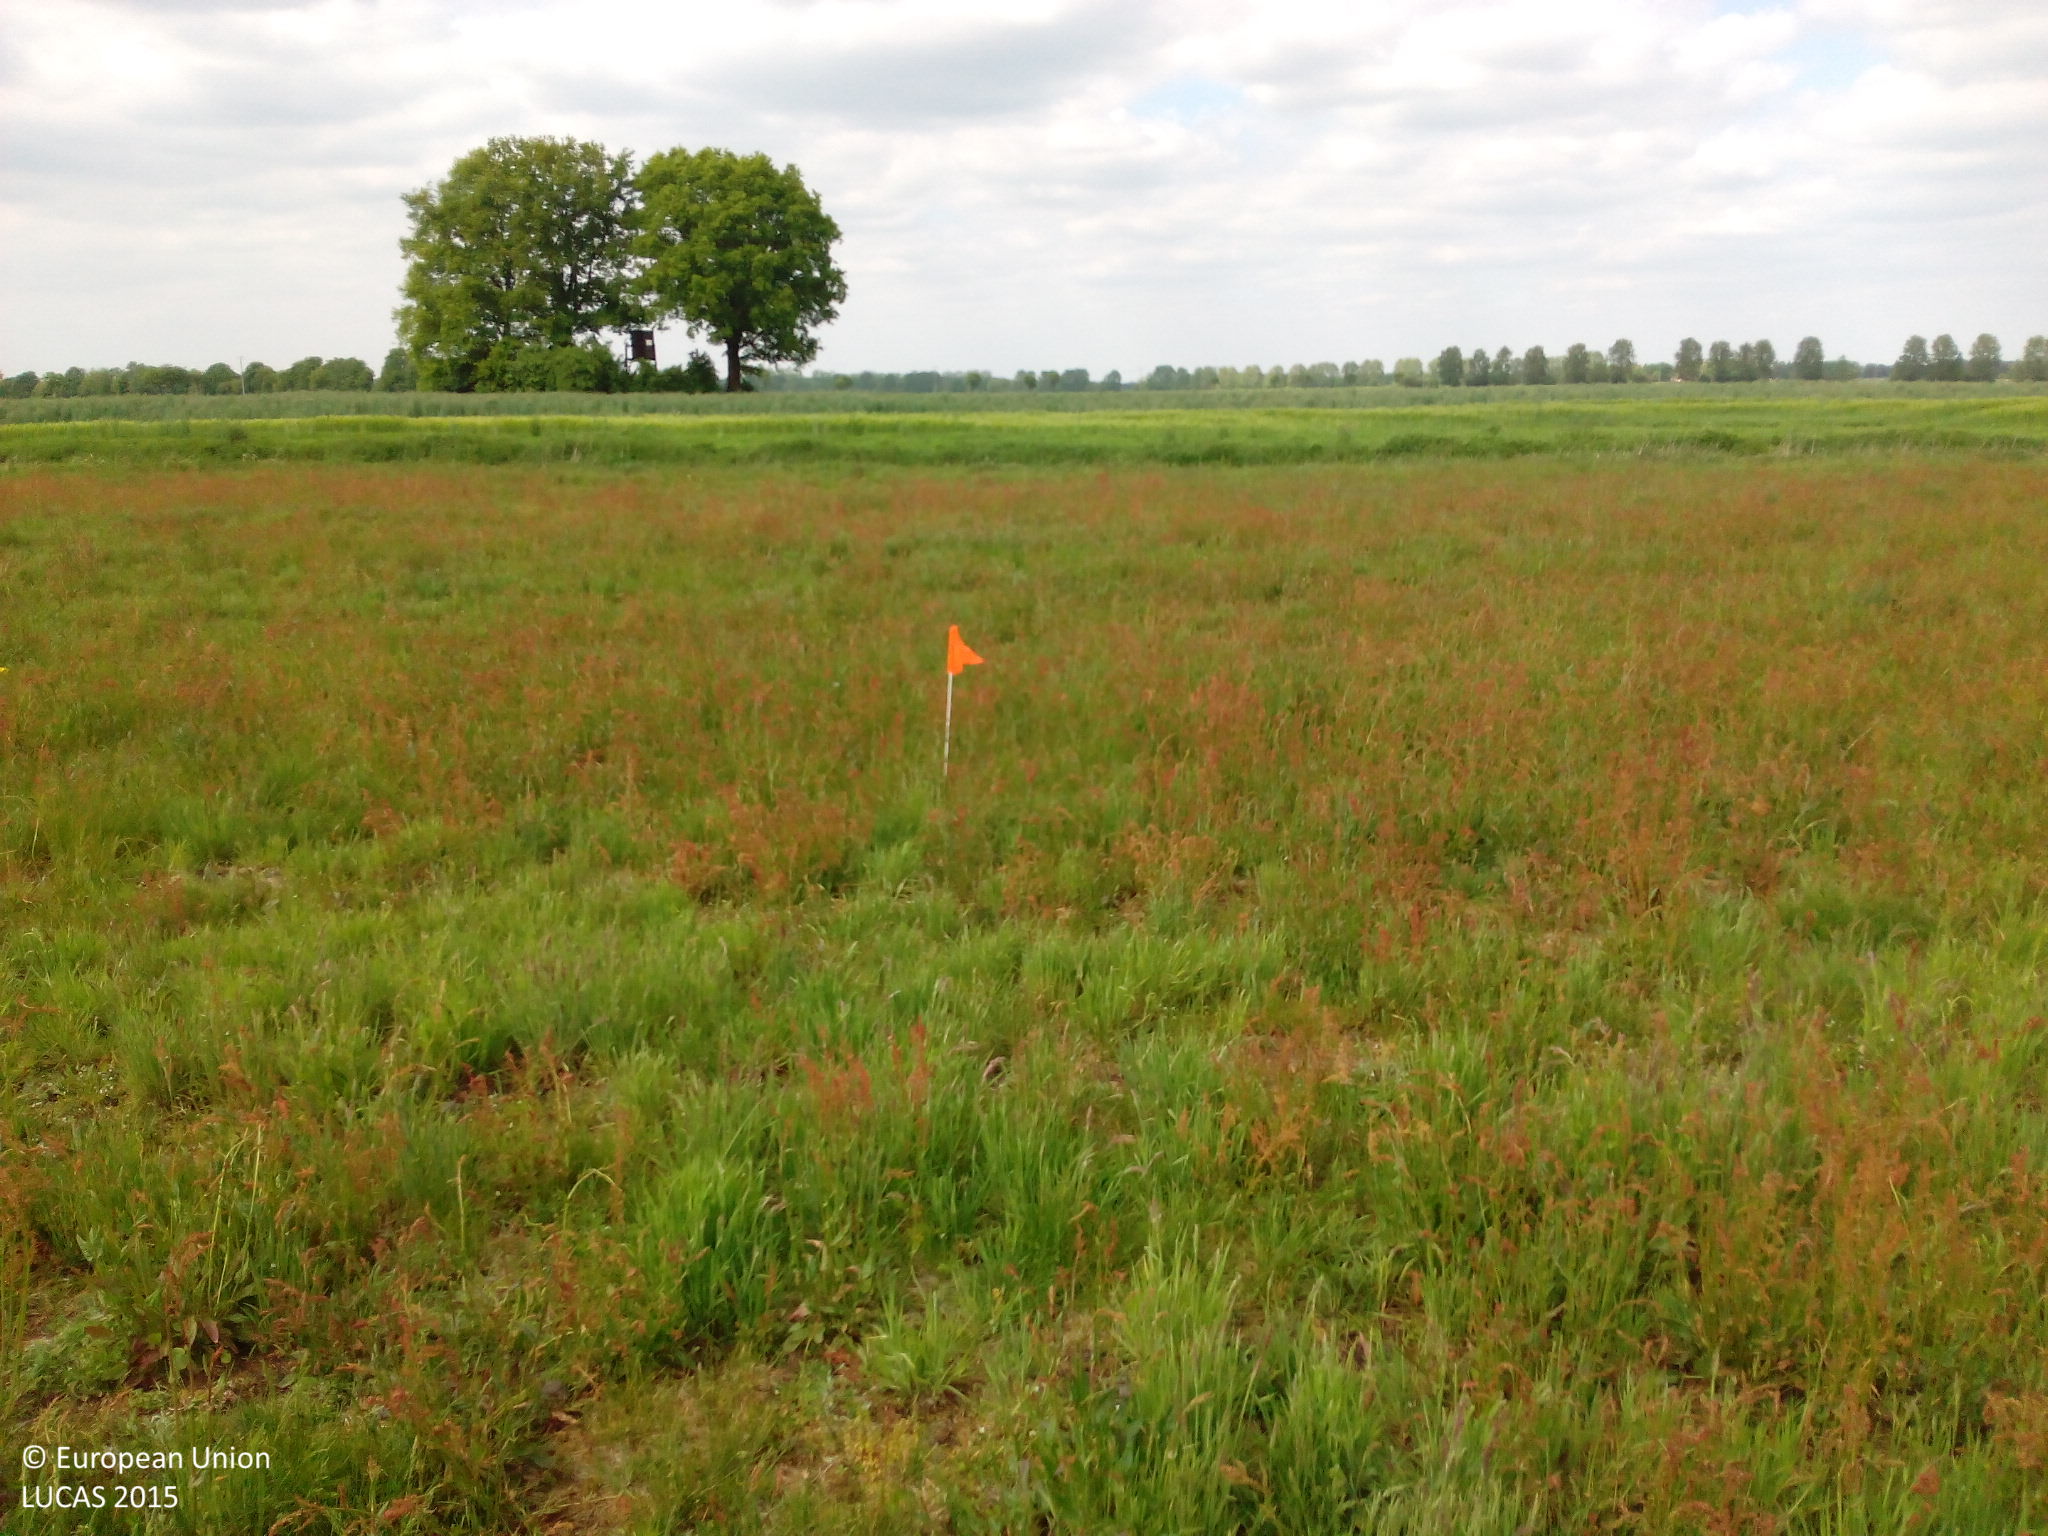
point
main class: Grassland
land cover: Grassland without tree/shrub cover
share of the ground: > 75 %
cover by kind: herbaceous plants 100 %
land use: Agriculture (excluding fallow land and kitchen gardens)
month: May
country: DE
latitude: 53.4627
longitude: 11.6411
